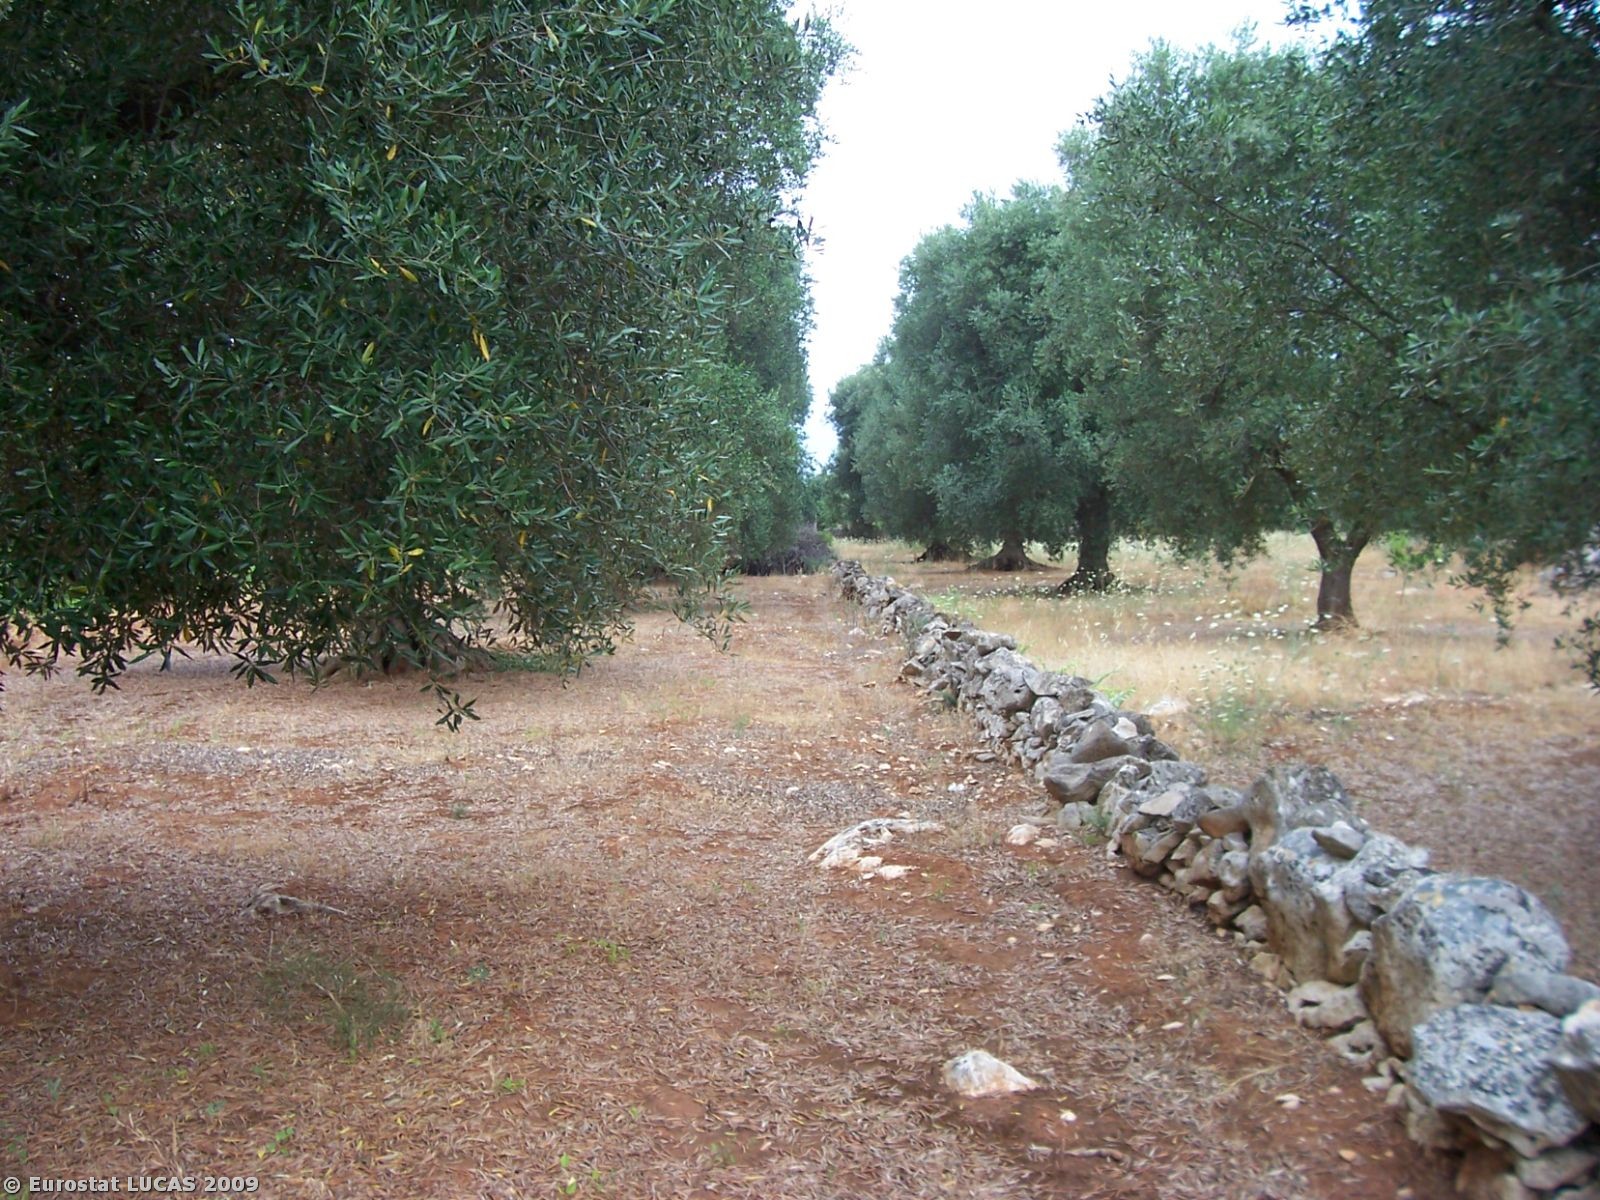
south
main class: Cropland
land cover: Olive groves
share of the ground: 25 - 50 %
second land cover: Bare land
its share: > 75 %
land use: Agriculture (excluding fallow land and kitchen gardens)
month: June
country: IT
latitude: 40.3957
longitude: 17.5271
